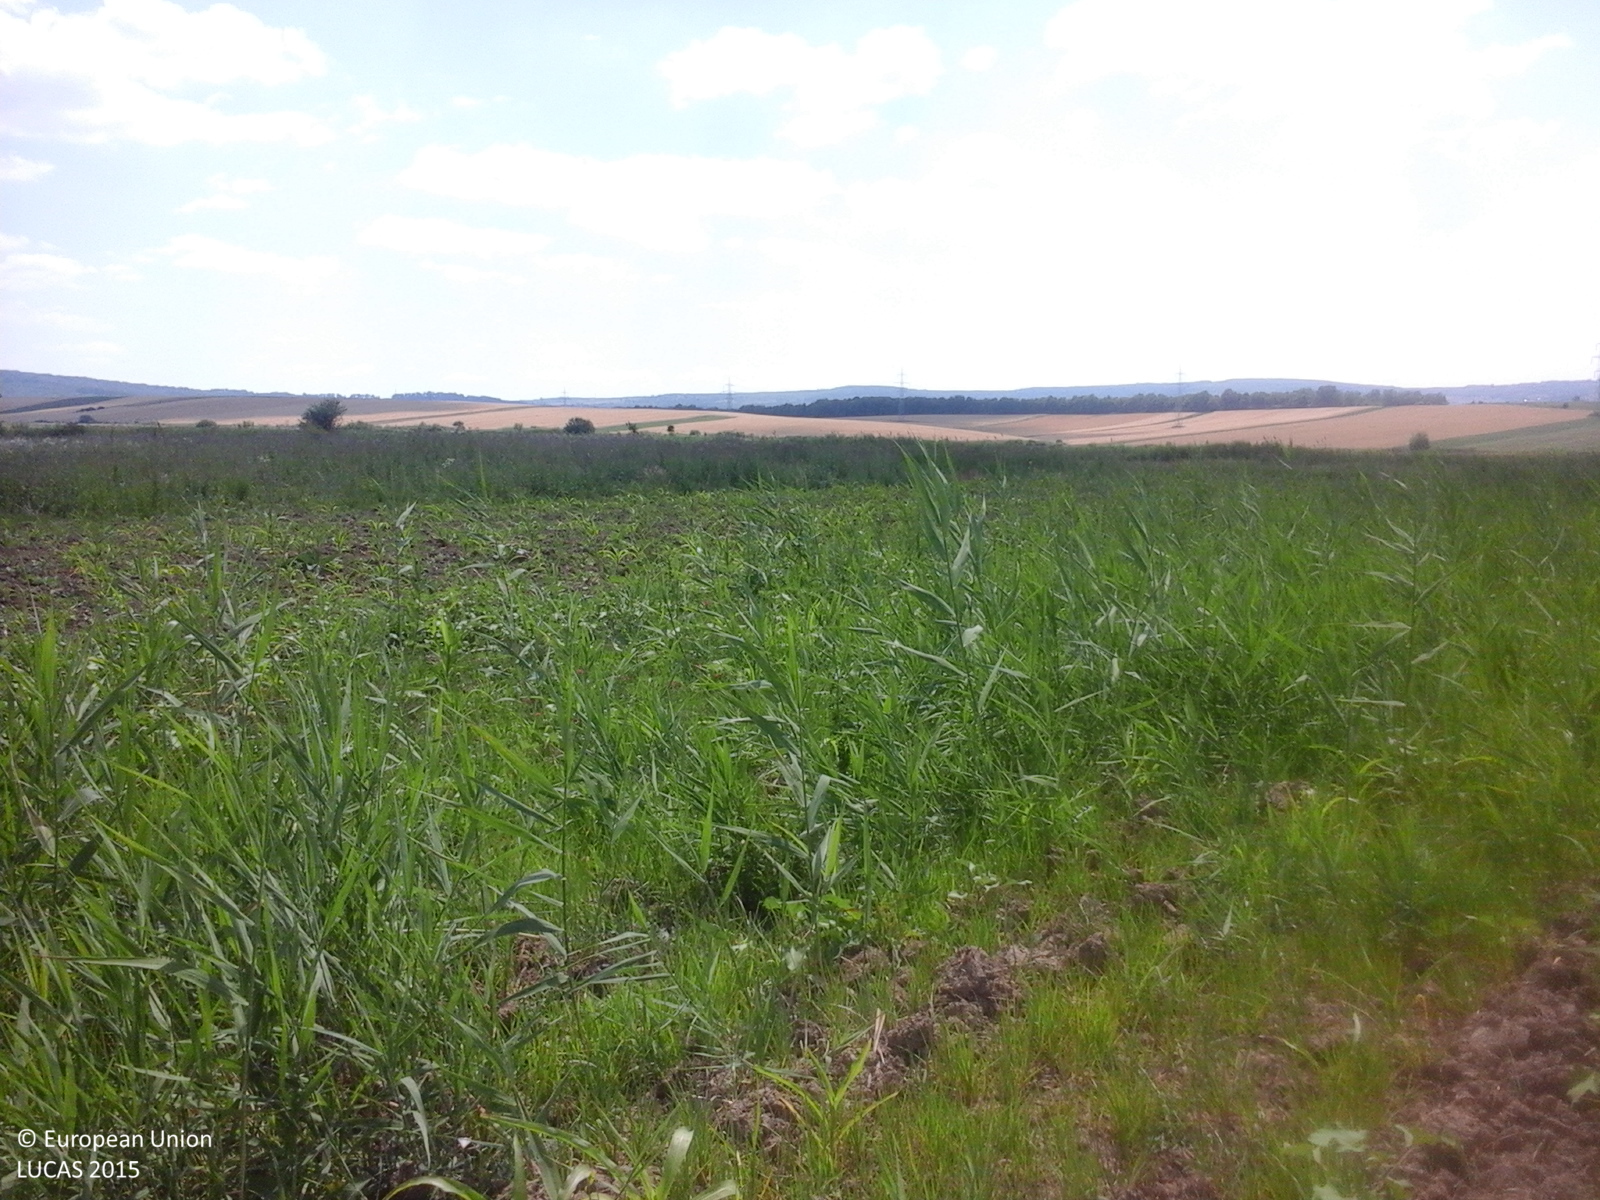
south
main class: Grassland
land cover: Spontaneously vegetated surfaces
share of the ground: > 75 %
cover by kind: herbaceous plants 100 %
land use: Fallow land
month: June
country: RO
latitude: 47.0567
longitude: 27.5606
